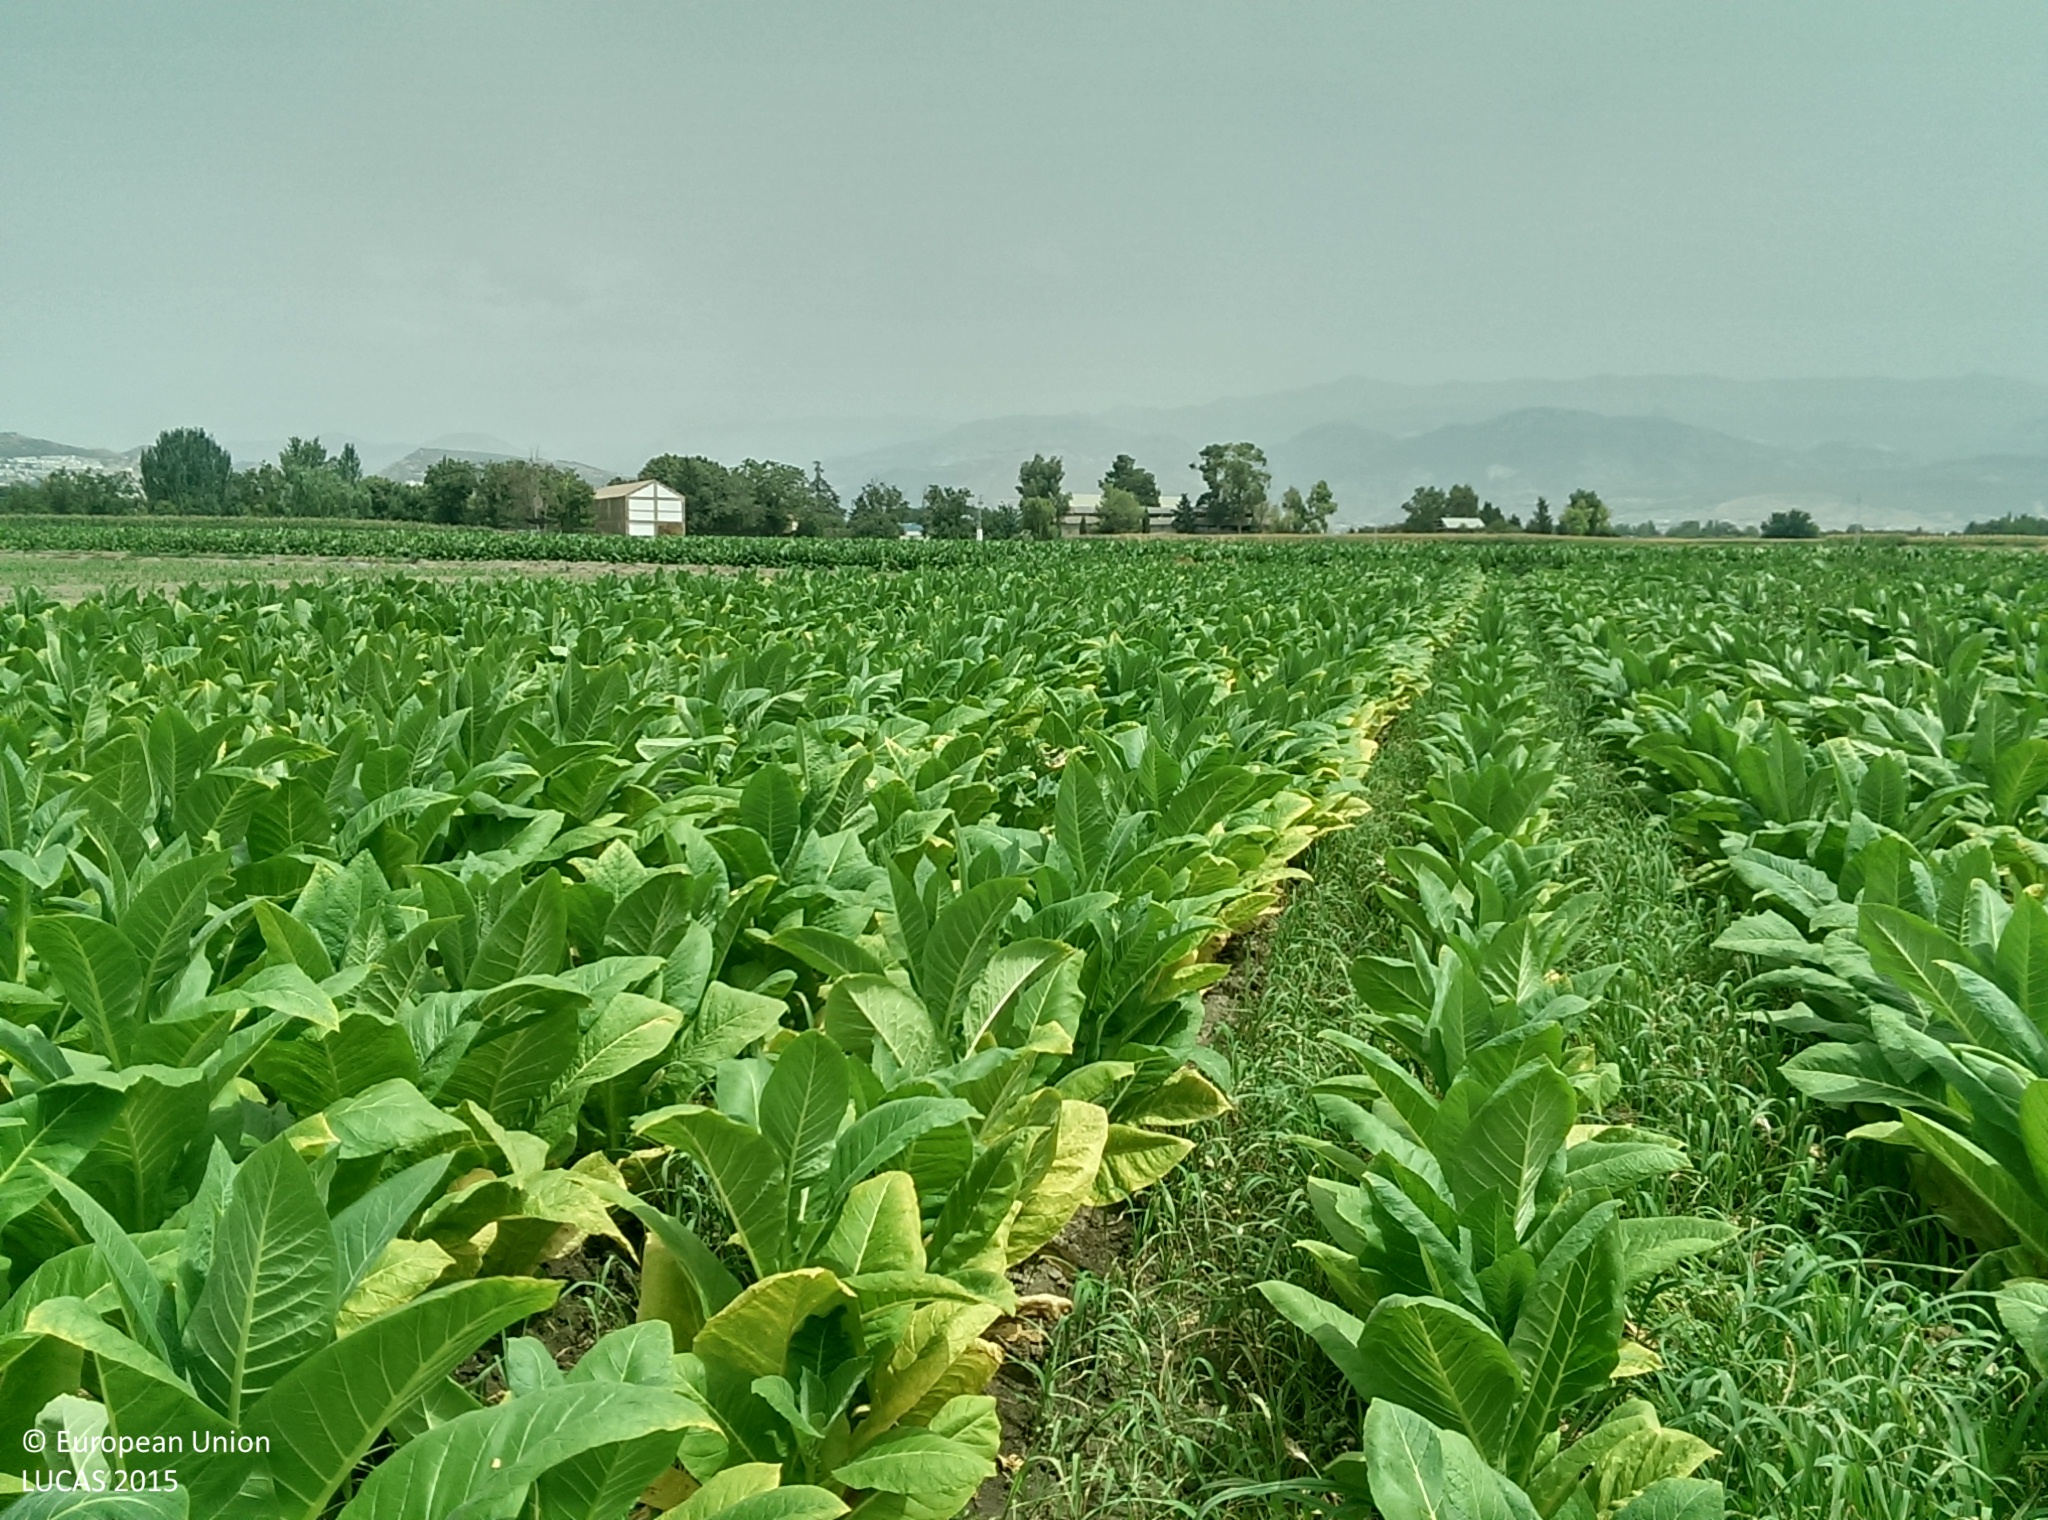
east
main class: Cropland
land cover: Tobacco
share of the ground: > 75 %
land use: Agriculture (excluding fallow land and kitchen gardens)
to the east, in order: Tobacco; Ditches and canals; Maize; Ditches and canals; Tobacco; Ditches and canals; Grass margins; Tracks; Grass margins; Fences; Maize
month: August
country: ES
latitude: 37.1803
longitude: -3.6526
